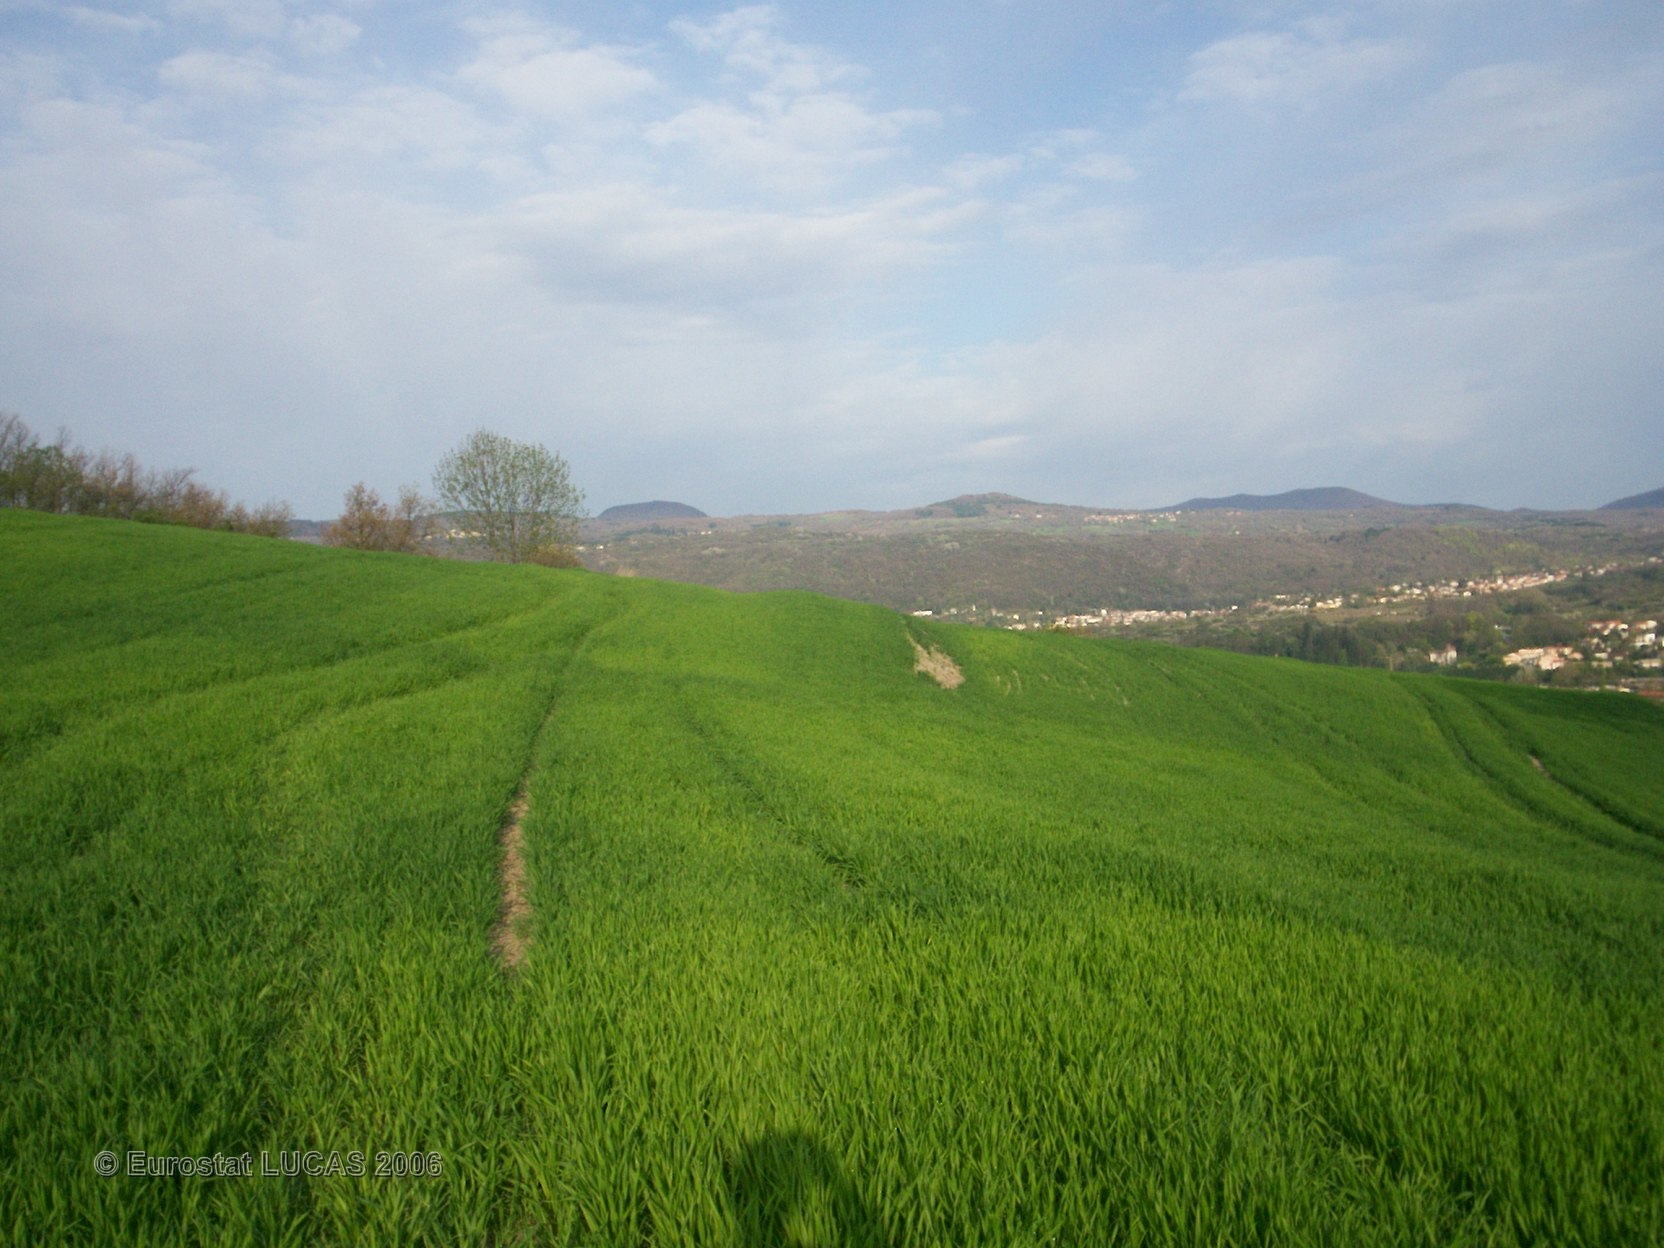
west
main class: Cropland
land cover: Common wheat
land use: Agriculture (excluding fallow land and kitchen gardens)
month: April
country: FR
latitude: 45.8202
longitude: 3.0879
